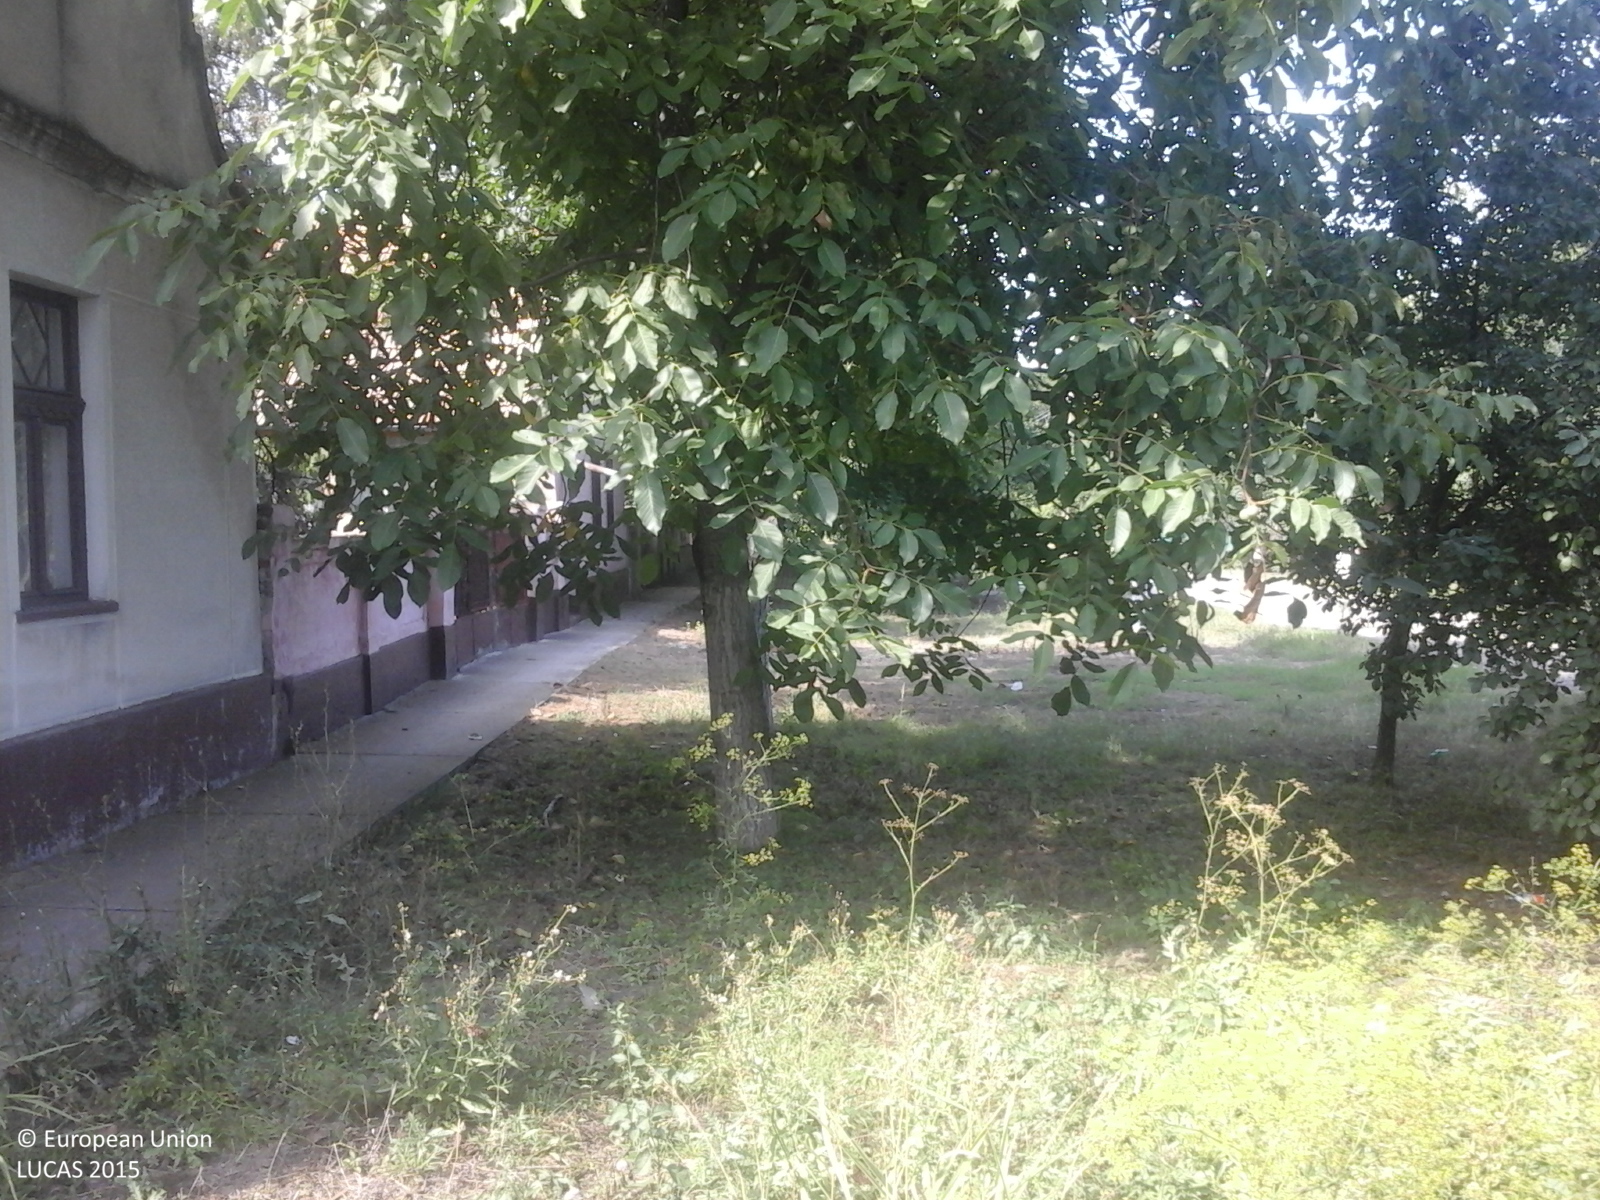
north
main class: Cropland
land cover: Vineyards
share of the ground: > 75 %
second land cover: Other bare soil
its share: > 75 %
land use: Kitchen garden
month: August
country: RO
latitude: 45.7617
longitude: 21.0213
